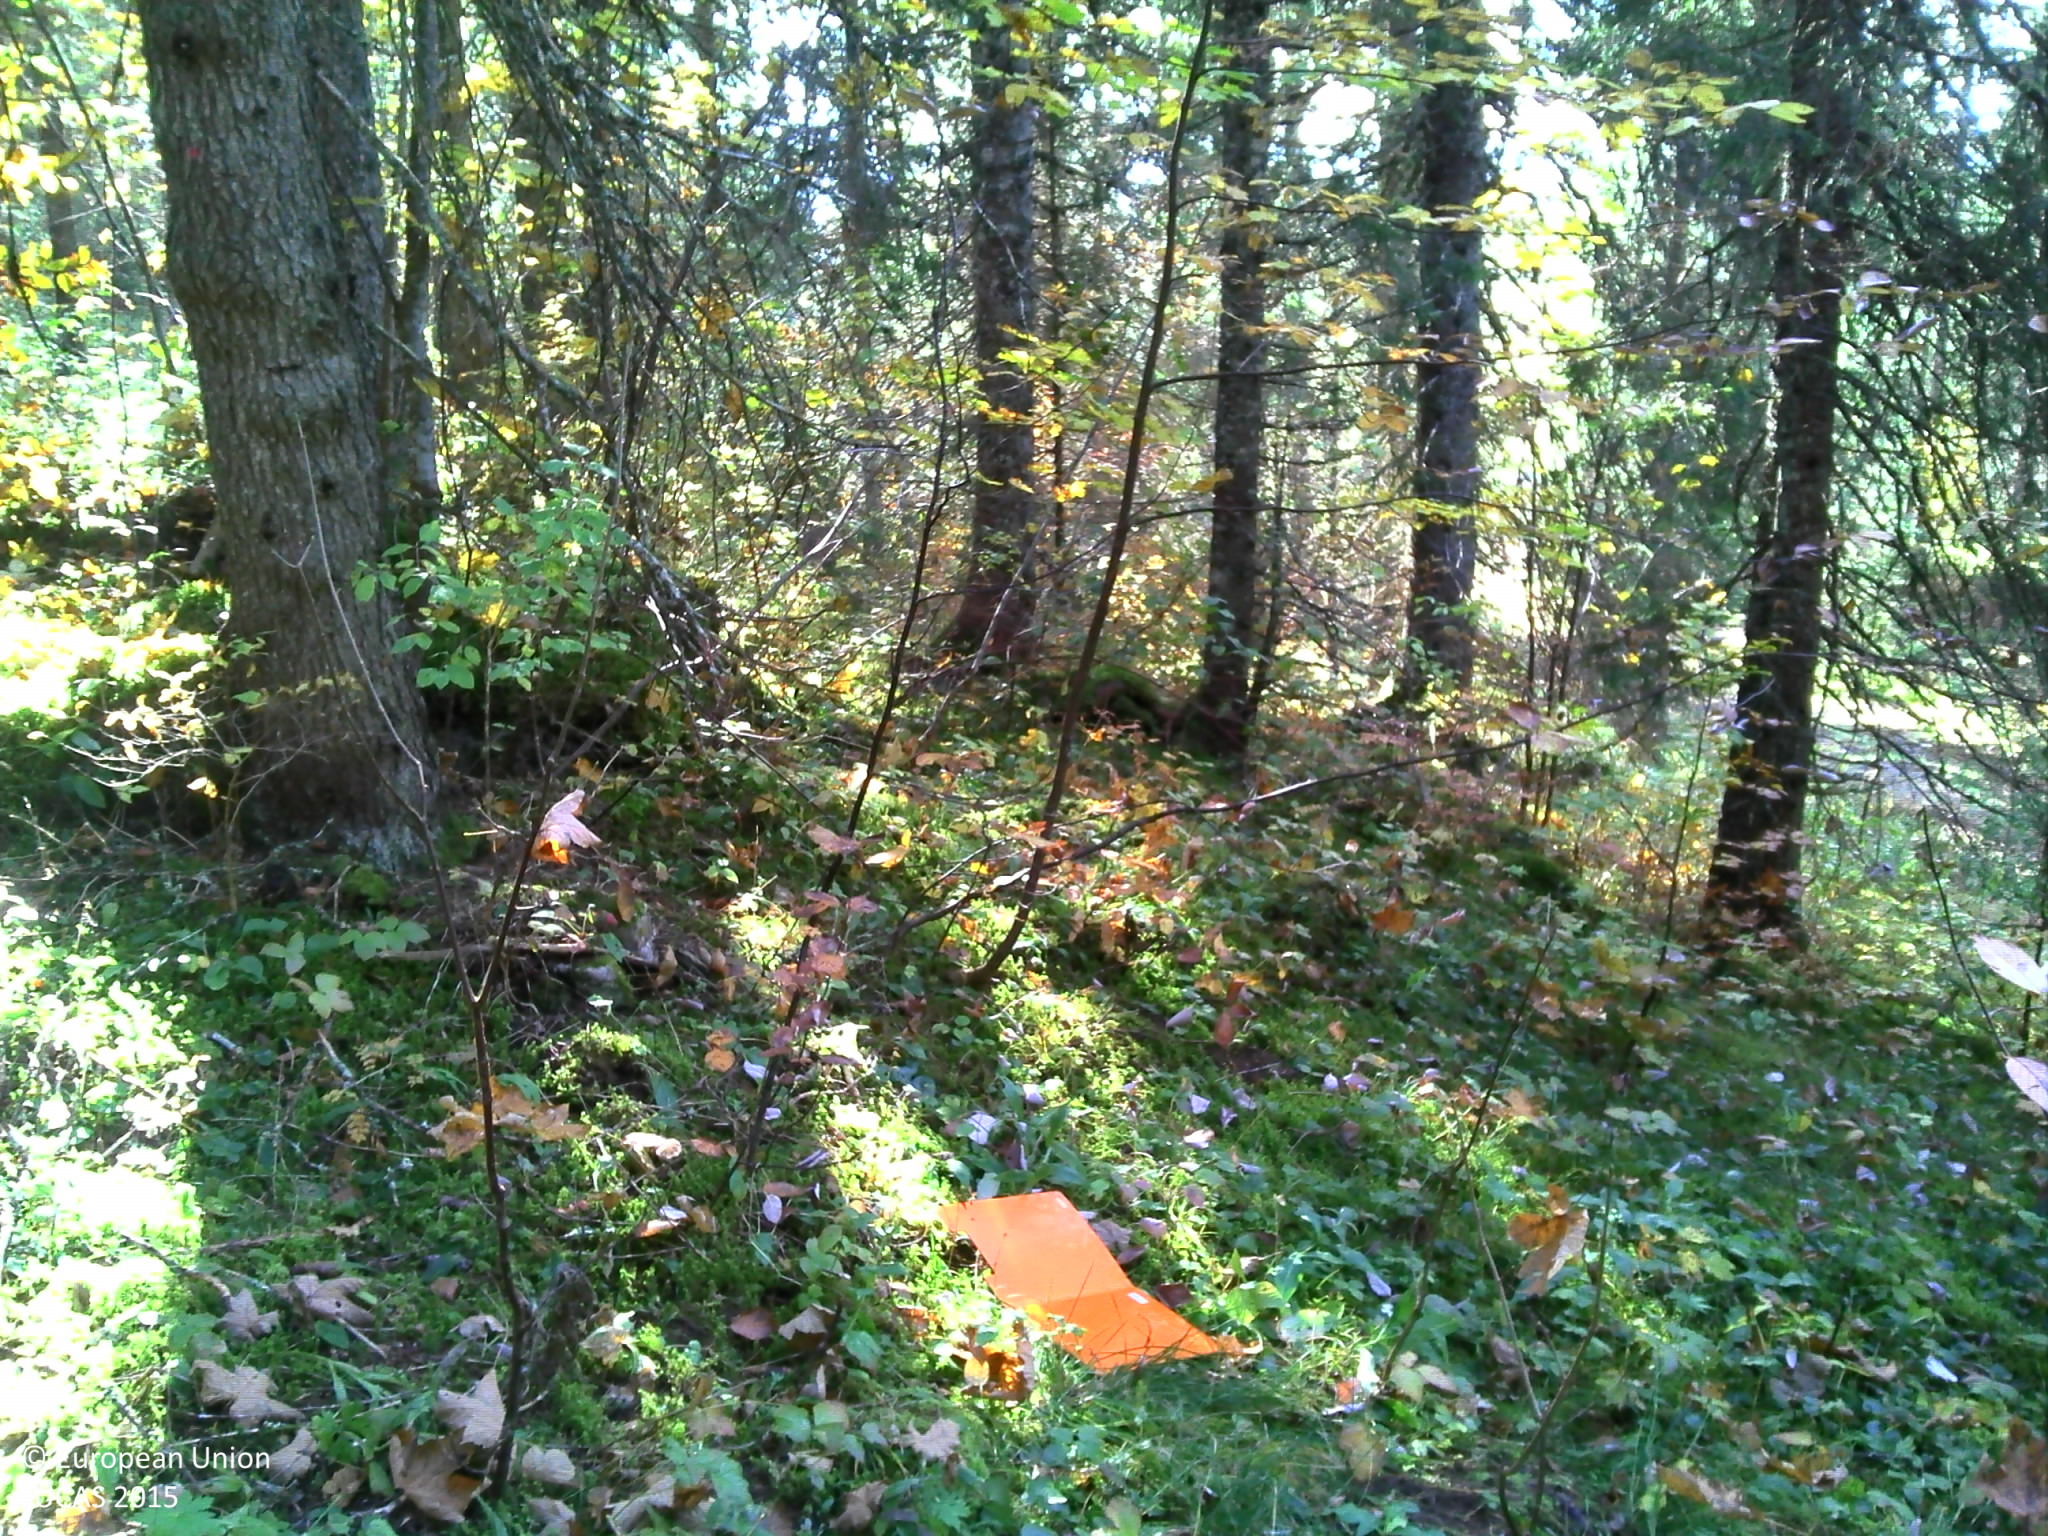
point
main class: Woodland
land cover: Spruce dominated coniferous woodland
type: hemiboreal forest and nemoral coniferous forest and mixed broadleaved-coniferous forest
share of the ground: > 75 %
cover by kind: coniferous forest trees 75 %, shrubs 10 %, herbaceous plants 10 %, broadleaved forest trees 5 %
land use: Forestry
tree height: > 5 m
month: October
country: FR
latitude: 46.6037
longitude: 6.0732
